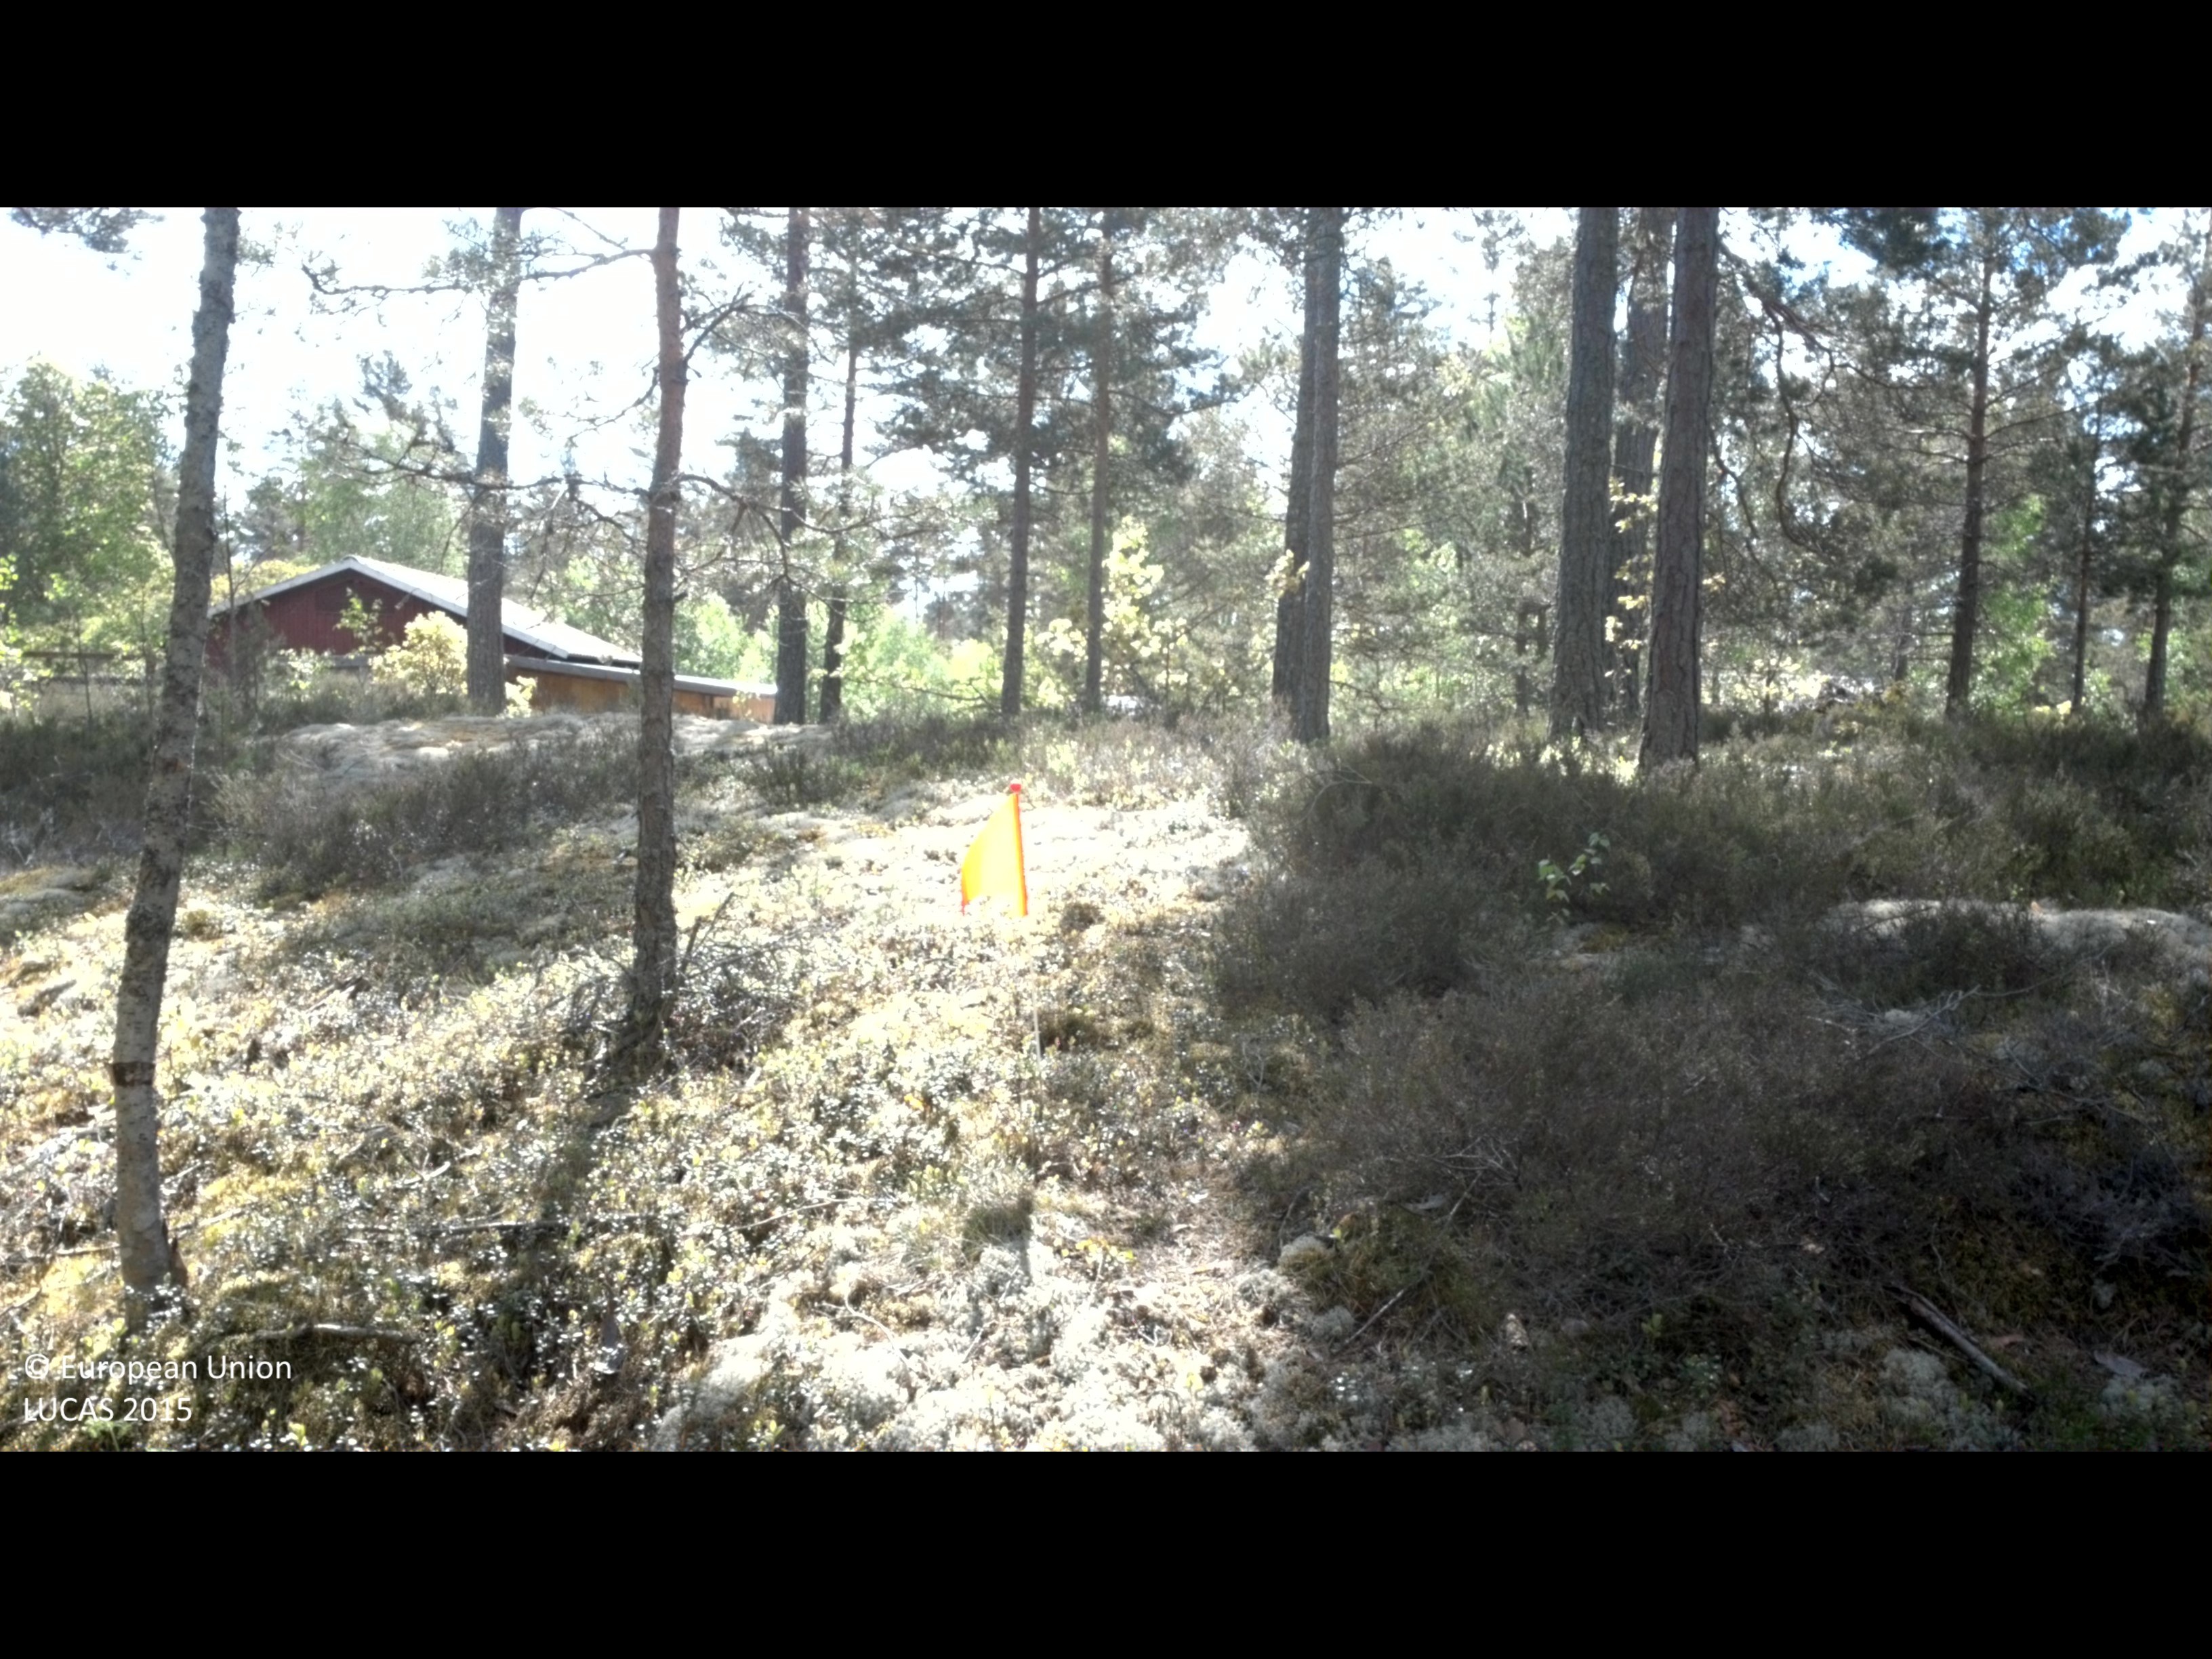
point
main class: Woodland
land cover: Pine dominated coniferous woodland
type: boreal forest
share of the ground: 50 - 75 %
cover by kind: coniferous forest trees 65 %, shrubs 15 %, lichens and mosses 15 %, broadleaved forest trees 5 %
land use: Forestry
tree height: > 5 m
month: May
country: SE
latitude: 57.5340
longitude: 16.5970
